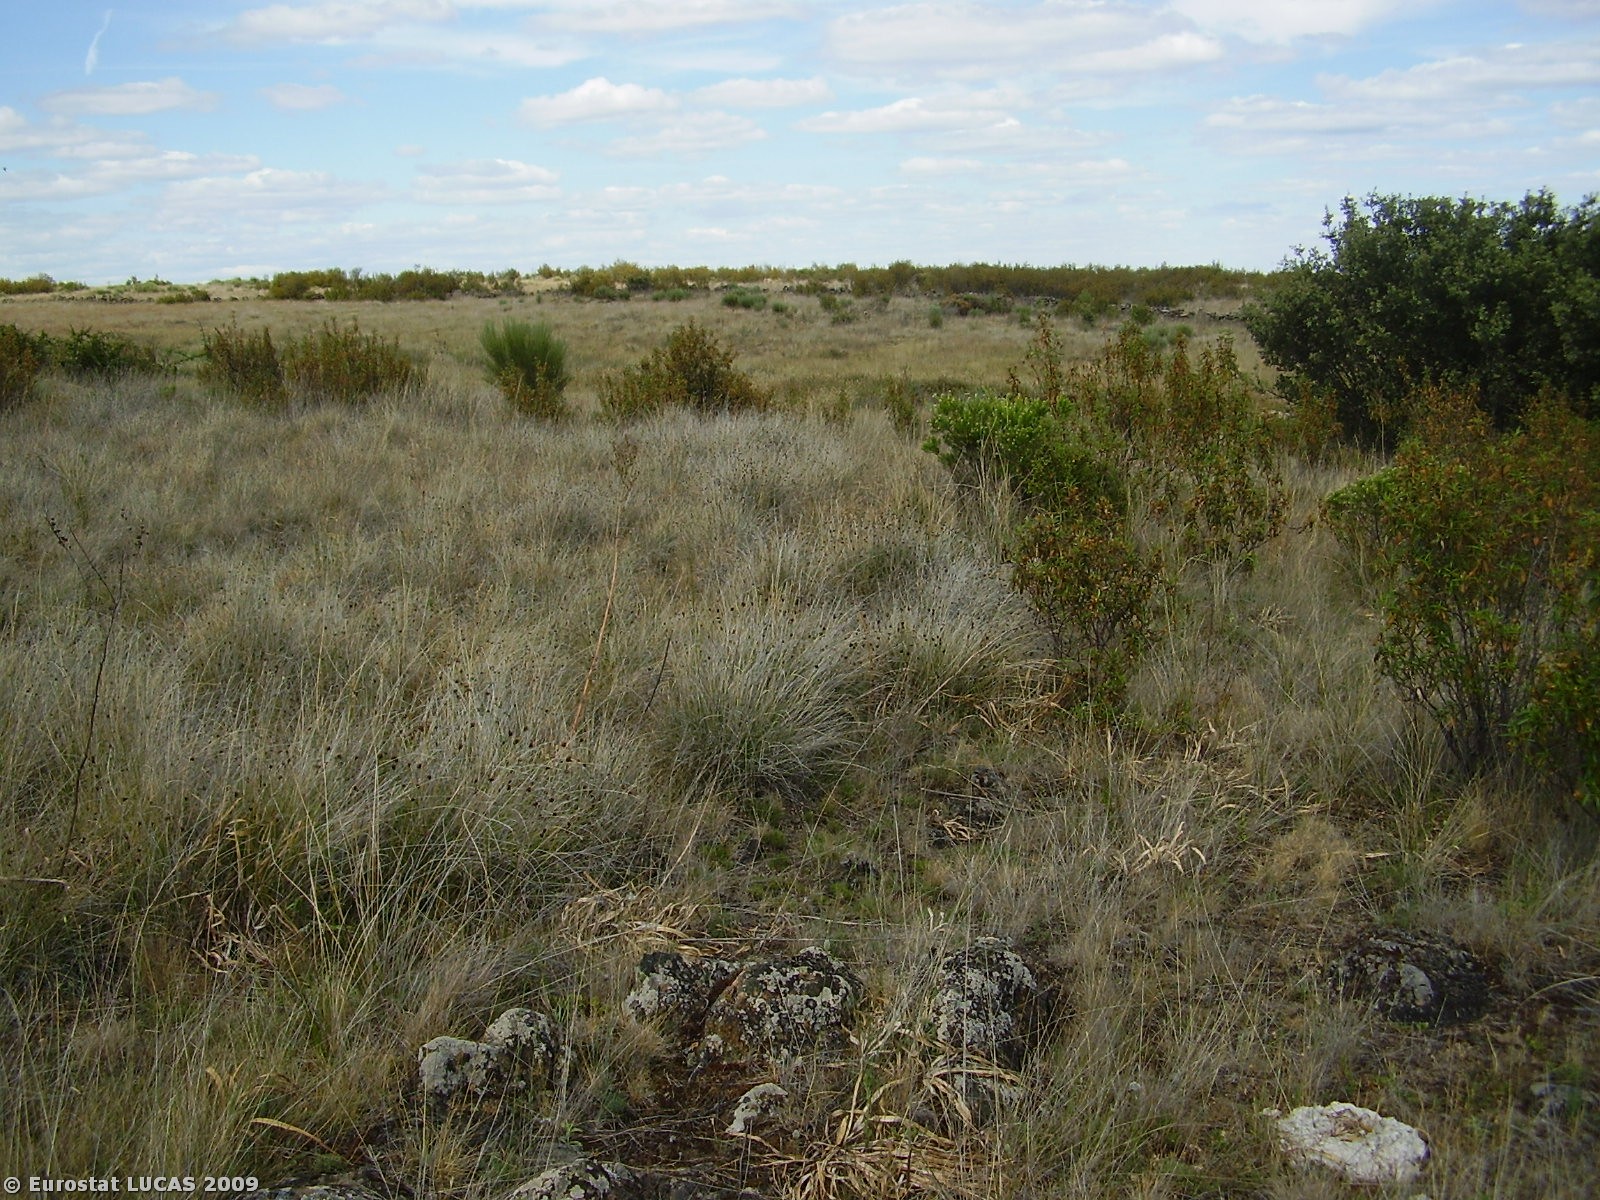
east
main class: Grassland
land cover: Spontaneously vegetated surfaces
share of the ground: > 75 %
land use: Fallow land
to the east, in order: Spontaneously vegetated surfaces; Single bushes/trees; Spontaneously vegetated surfaces; Dry stone walls; Artificial constructions in urban areas; Dry stone walls; Spontaneously vegetated surfaces; Dry stone walls; Spontaneously vegetated surfaces; Dry stone walls; Single bushes/trees; Dry stone walls; Spontaneously vegetated surfaces; Bare land
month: June
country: PT
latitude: 41.5013
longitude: -6.7729
